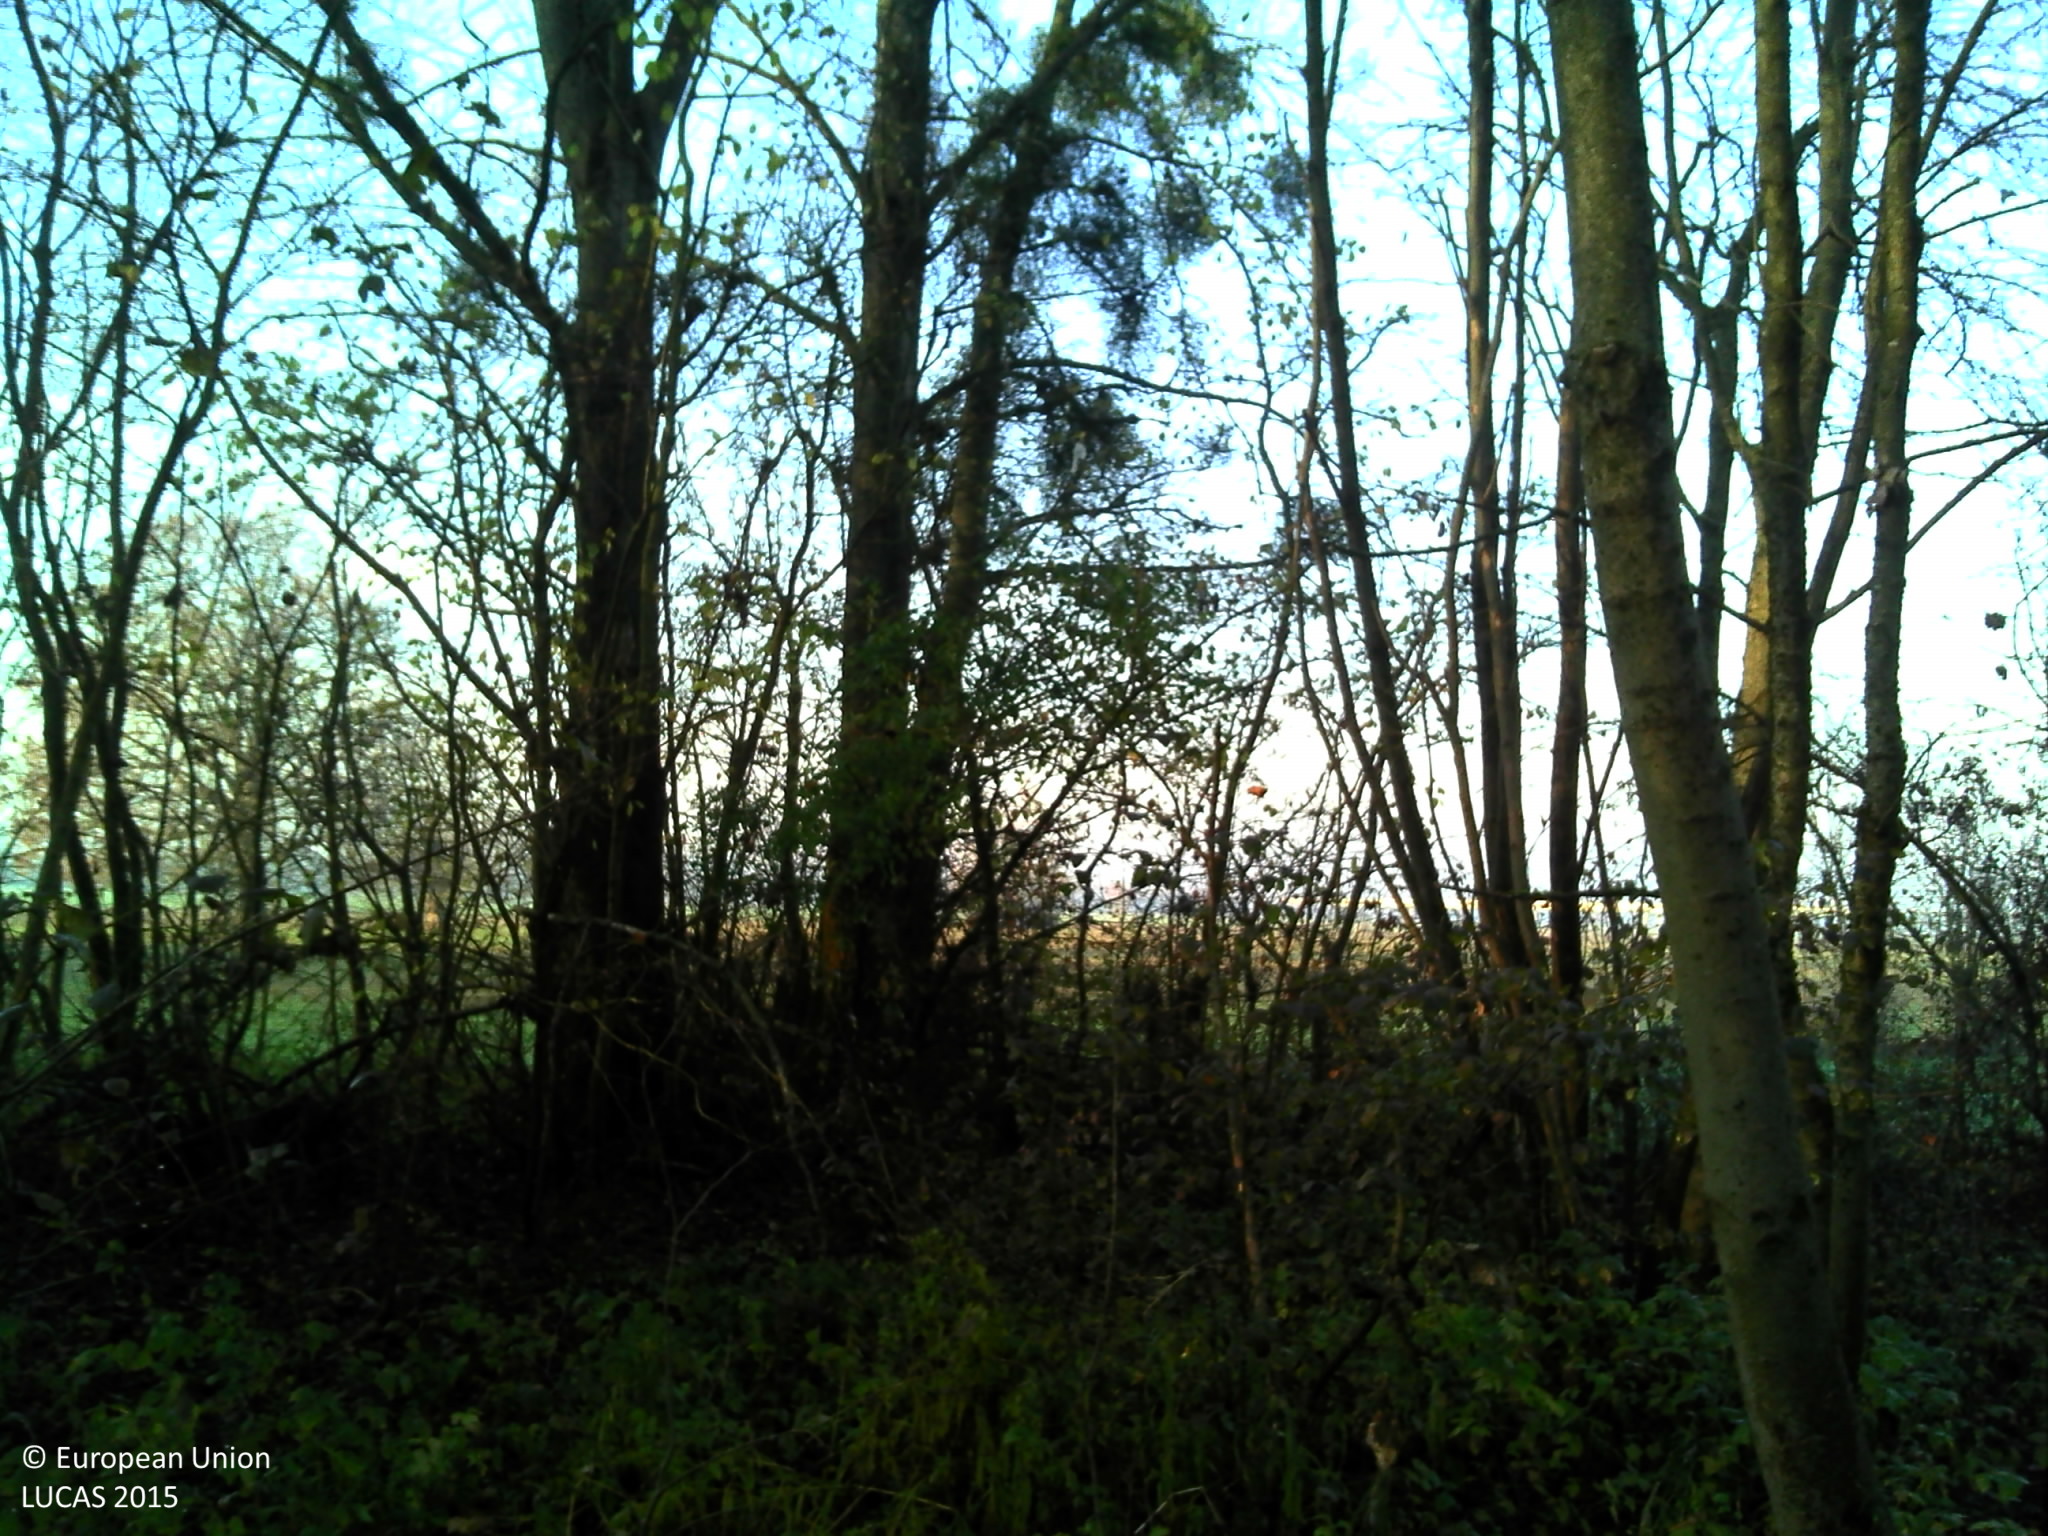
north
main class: Woodland
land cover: Broadleaved woodland
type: floodplain forest
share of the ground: > 75 %
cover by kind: broadleaved forest trees 90 %, herbaceous plants 10 %
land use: Semi-natural and natural areas not in use
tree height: > 5 m
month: December
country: FR
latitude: 46.2621
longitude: 4.8258
